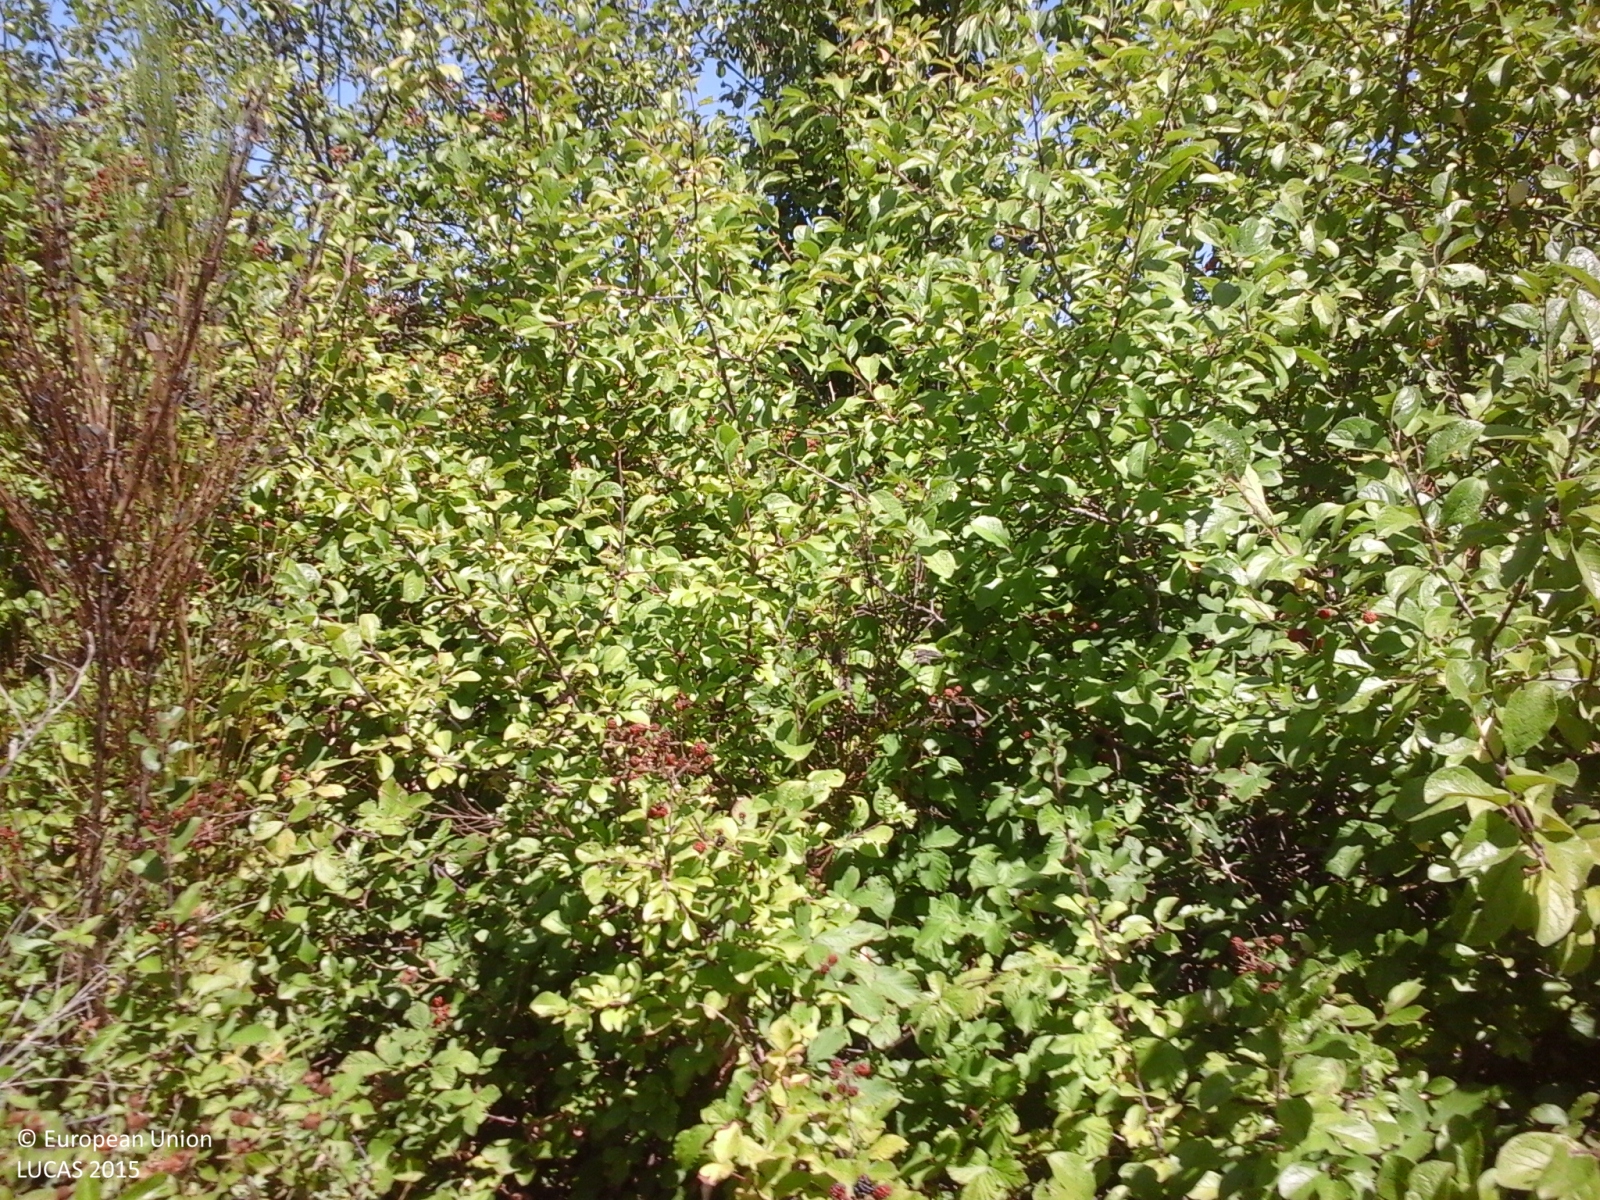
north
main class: Shrubland
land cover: Shrubland with sparse tree cover
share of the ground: > 75 %
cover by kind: shrubs 70 %, herbaceous plants 25 %, broadleaved forest trees 5 %
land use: Semi-natural and natural areas not in use
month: August
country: IT
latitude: 42.6776
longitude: 11.5934
